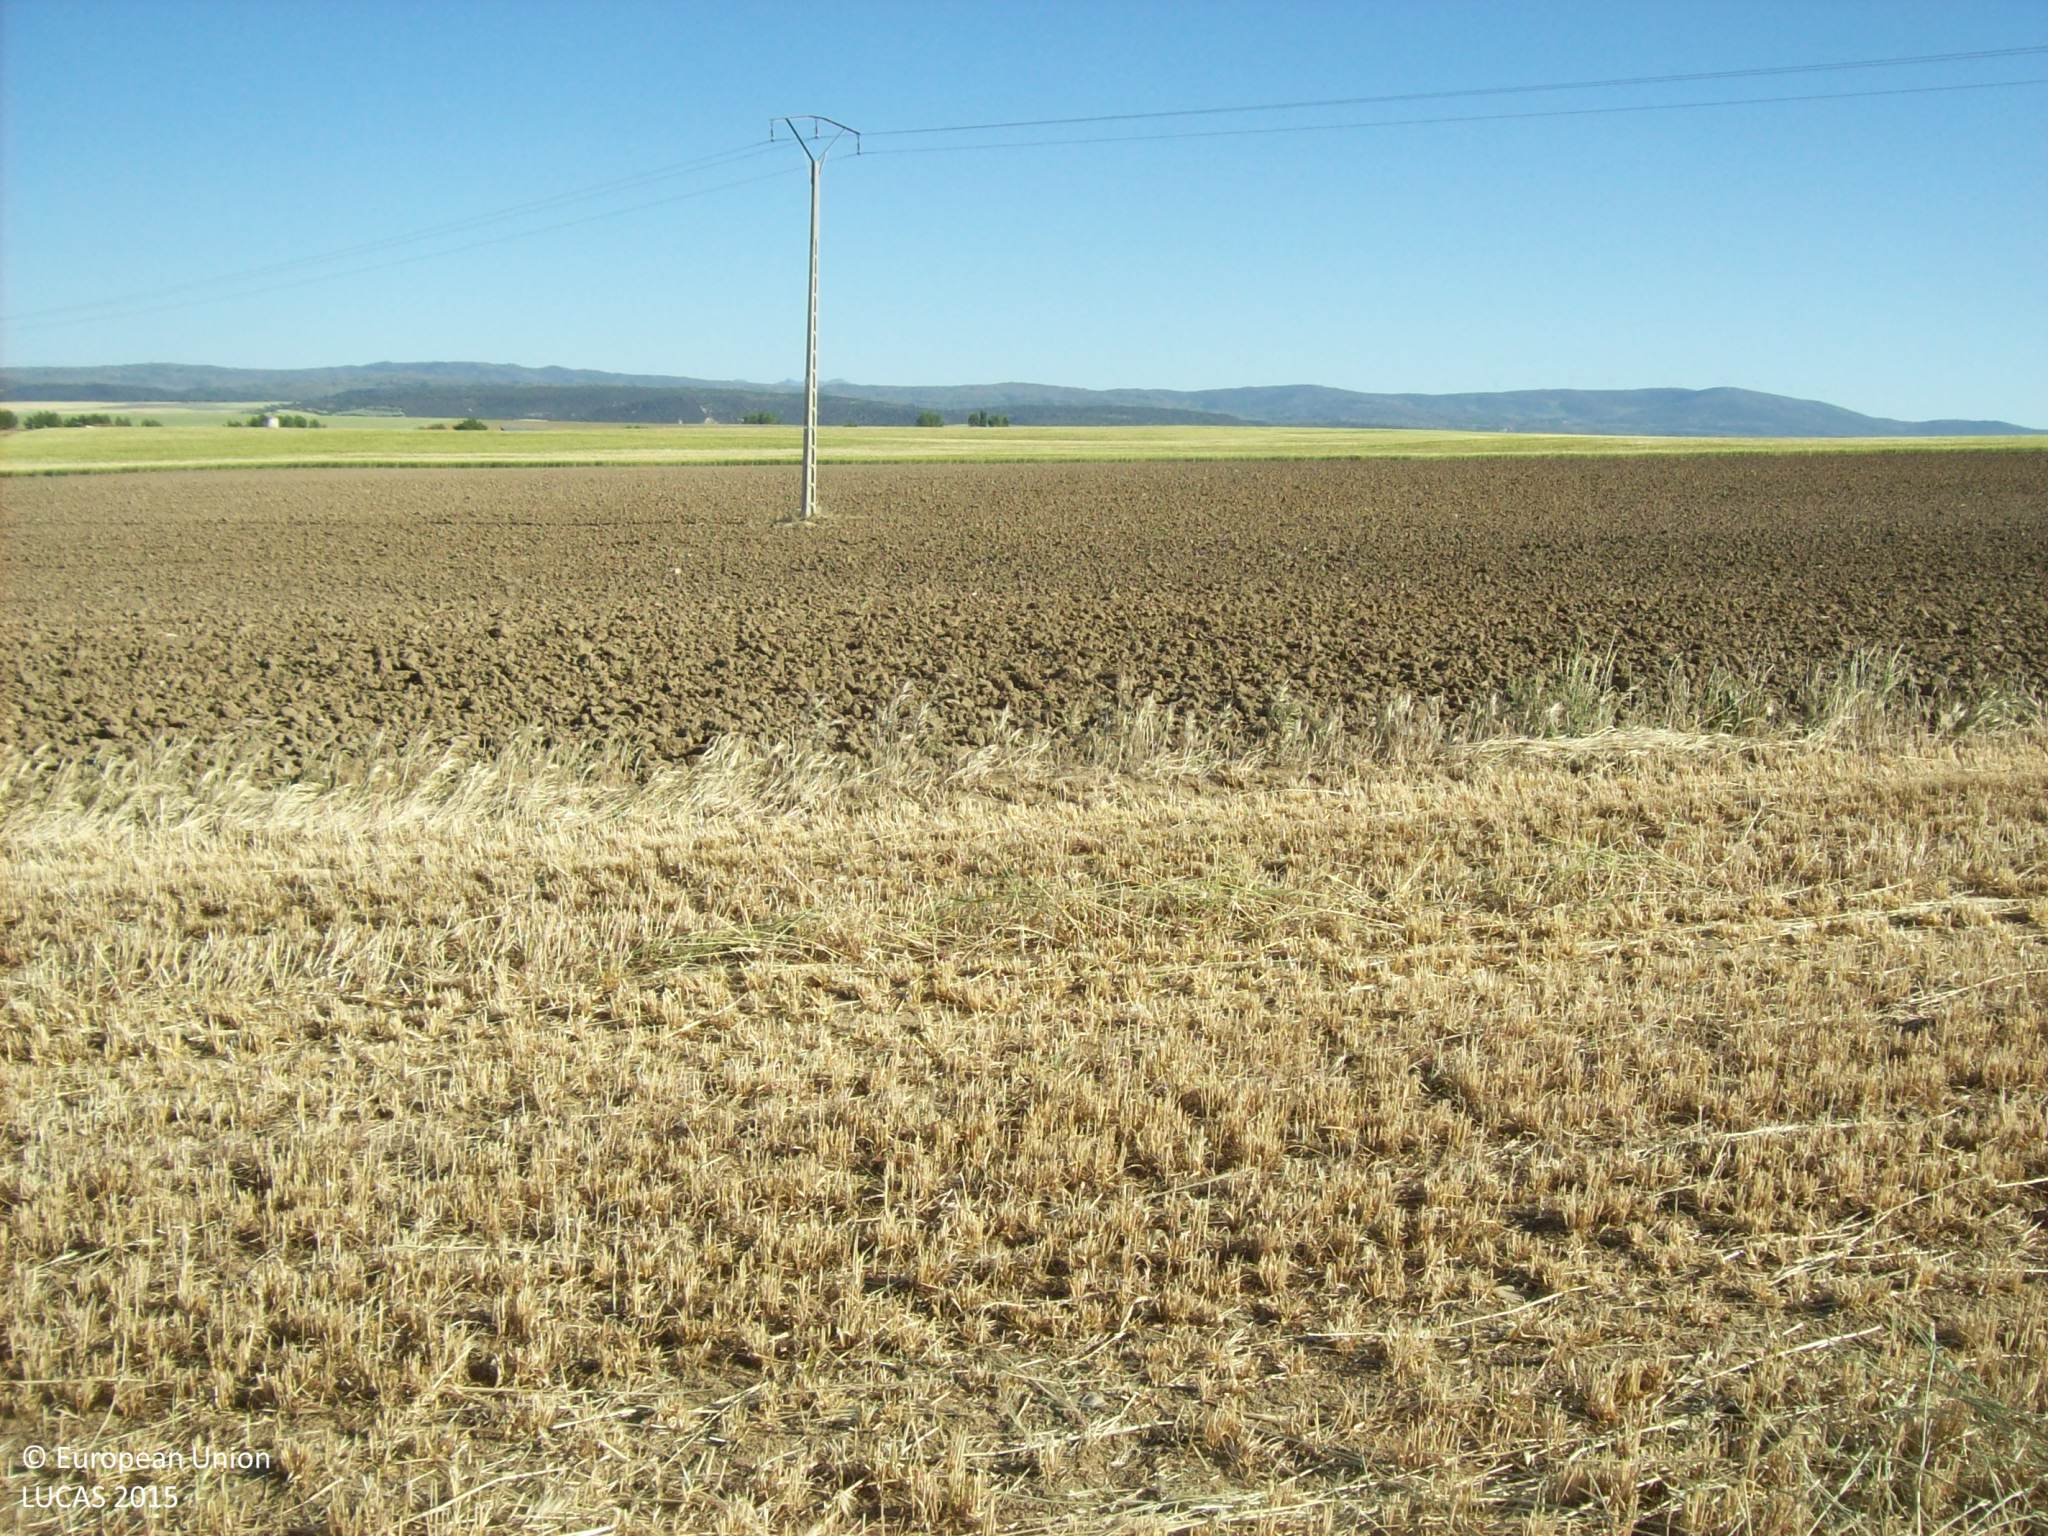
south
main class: Cropland
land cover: Oats
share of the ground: > 75 %
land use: Agriculture (excluding fallow land and kitchen gardens)
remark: Harvested field
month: May
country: ES
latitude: 40.8054
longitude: -4.9380
